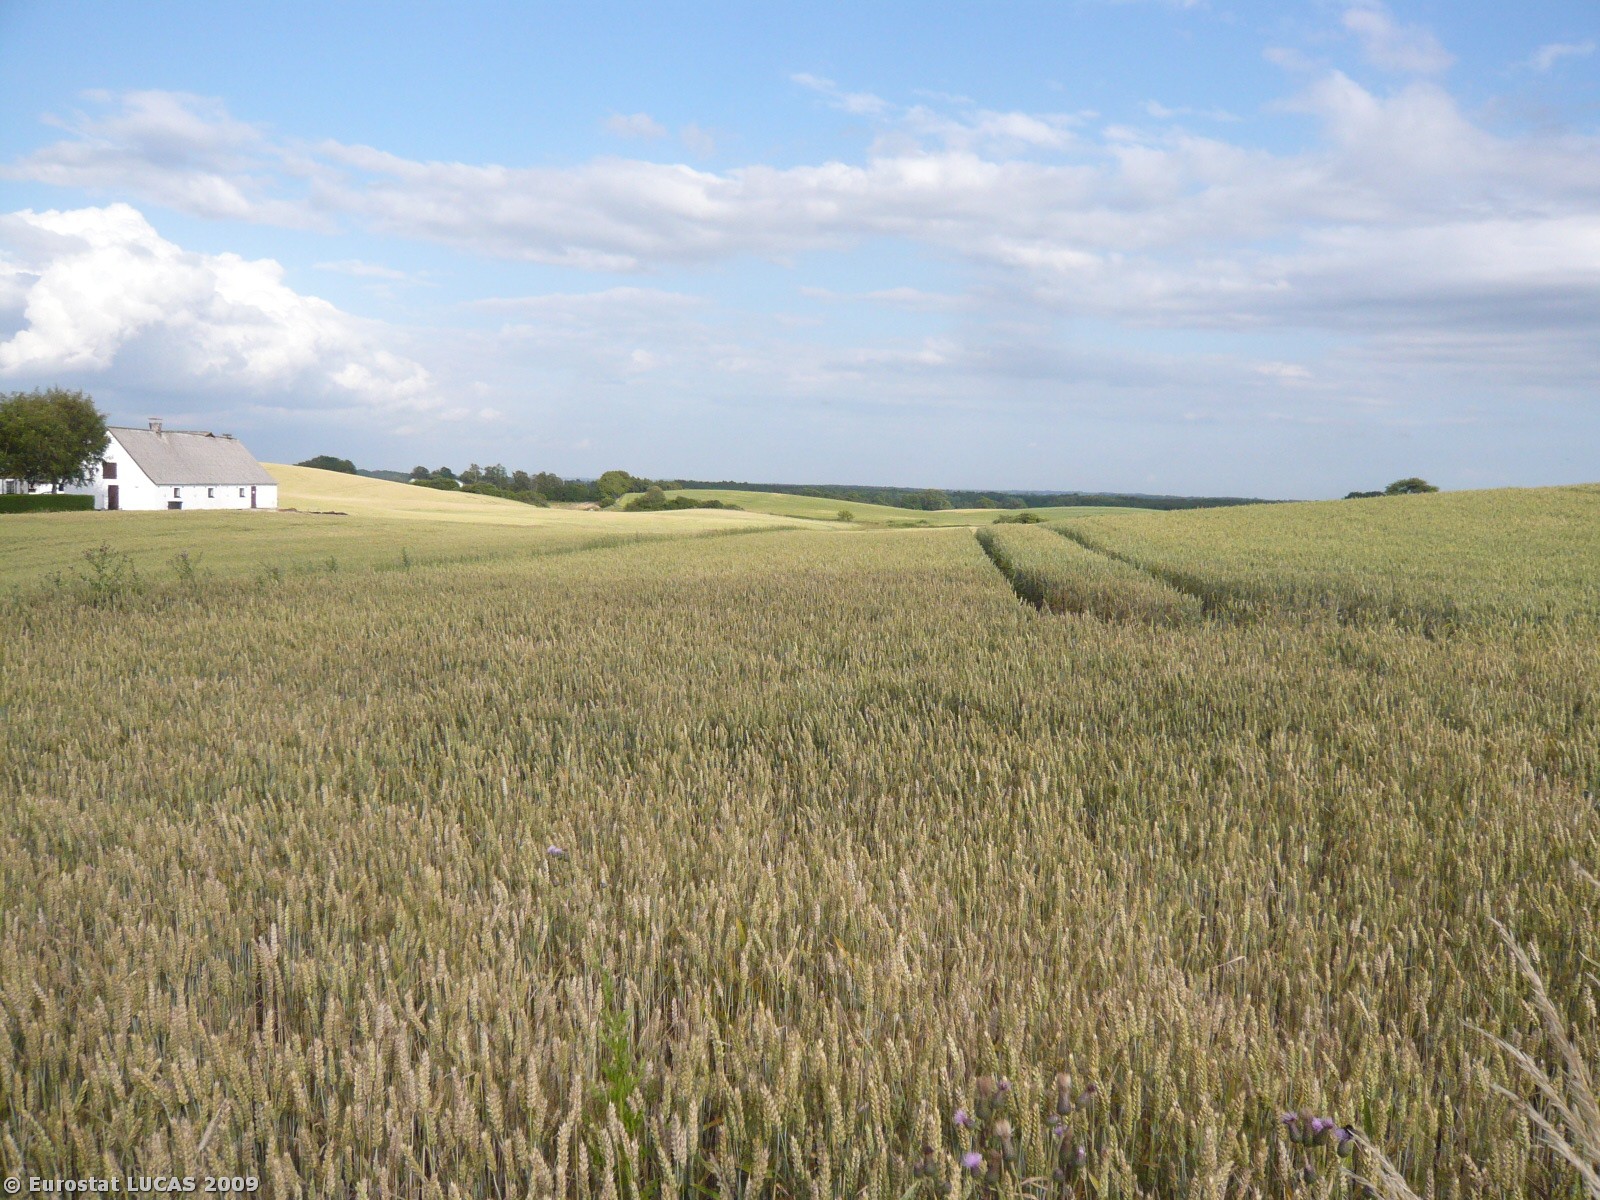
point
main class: Cropland
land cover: Common wheat
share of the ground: > 75 %
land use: Agriculture (excluding fallow land and kitchen gardens)
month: July
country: DK
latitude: 55.6036
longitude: 11.5065
